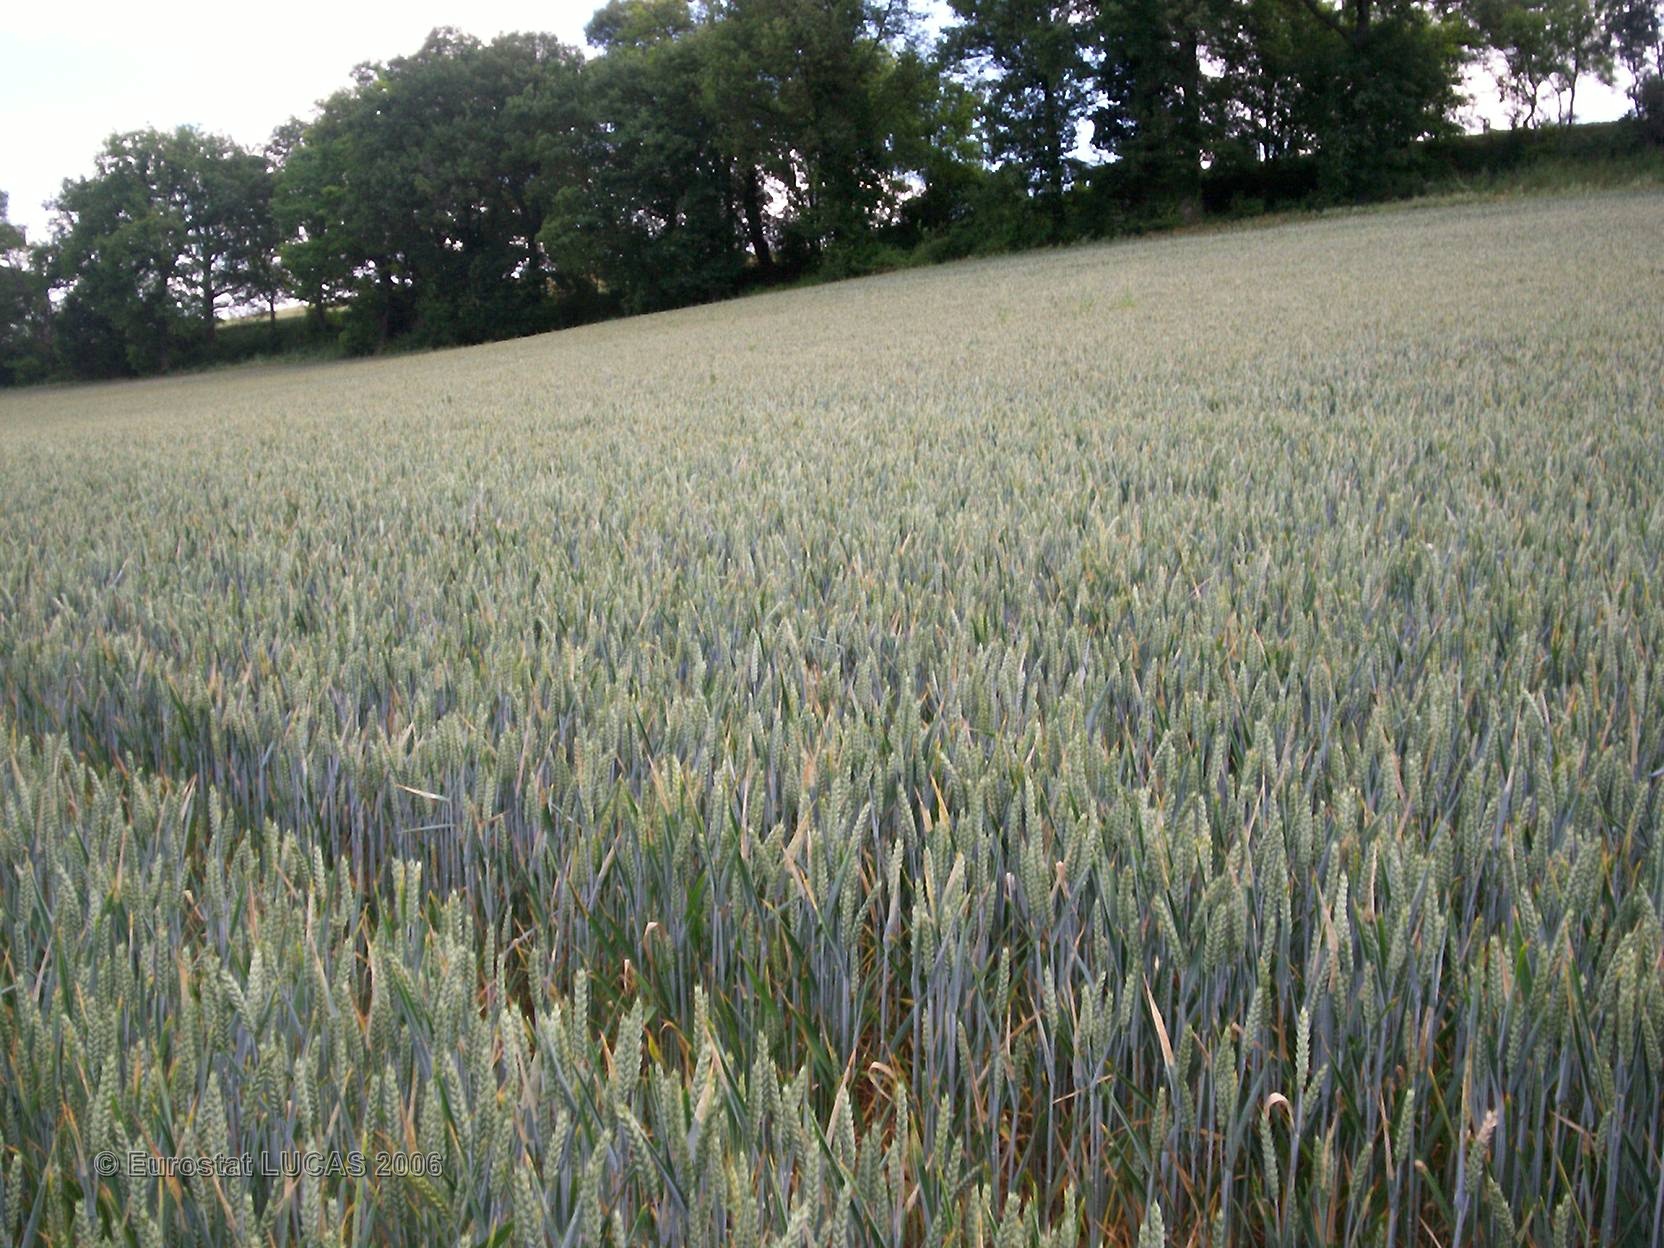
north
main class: Grassland
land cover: Grassland without tree/shrub cover
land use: Agriculture (excluding fallow land and kitchen gardens)
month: May
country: FR
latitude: 43.5039
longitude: 0.9844
